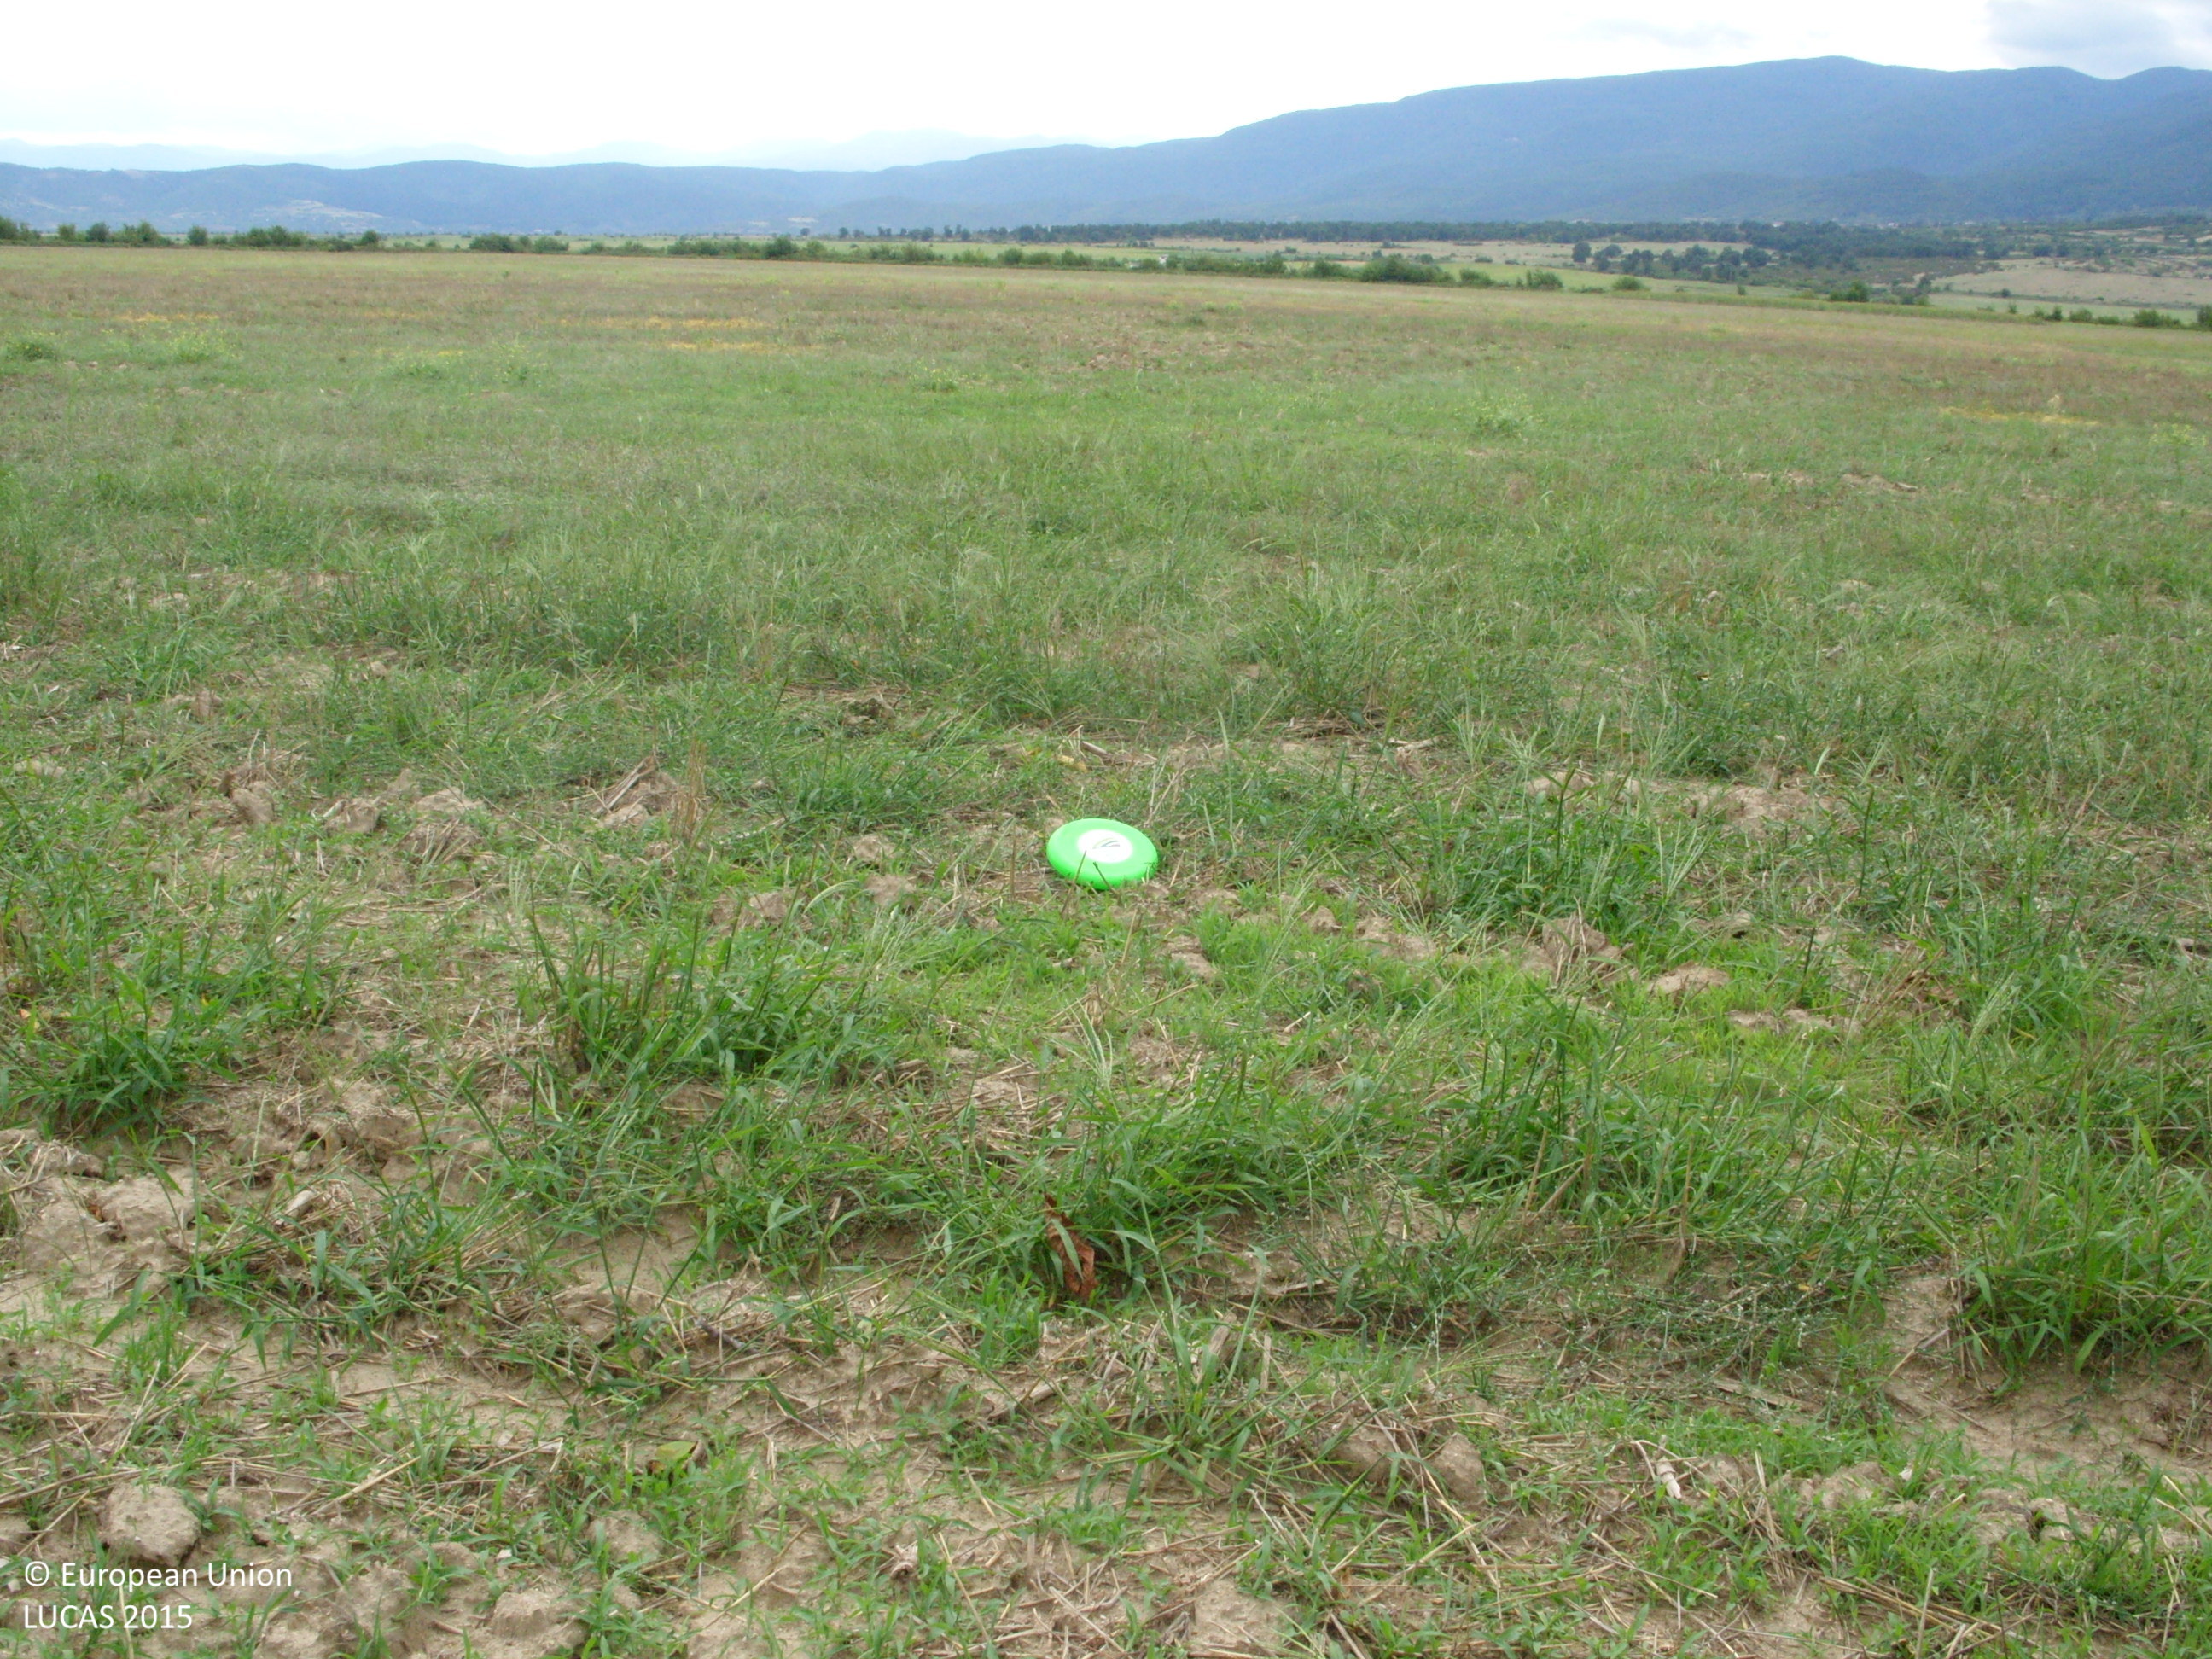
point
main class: Cropland
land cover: Common wheat
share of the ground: < 10 %
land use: Agriculture (excluding fallow land and kitchen gardens)
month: September
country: BG
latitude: 42.1617
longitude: 24.1910
